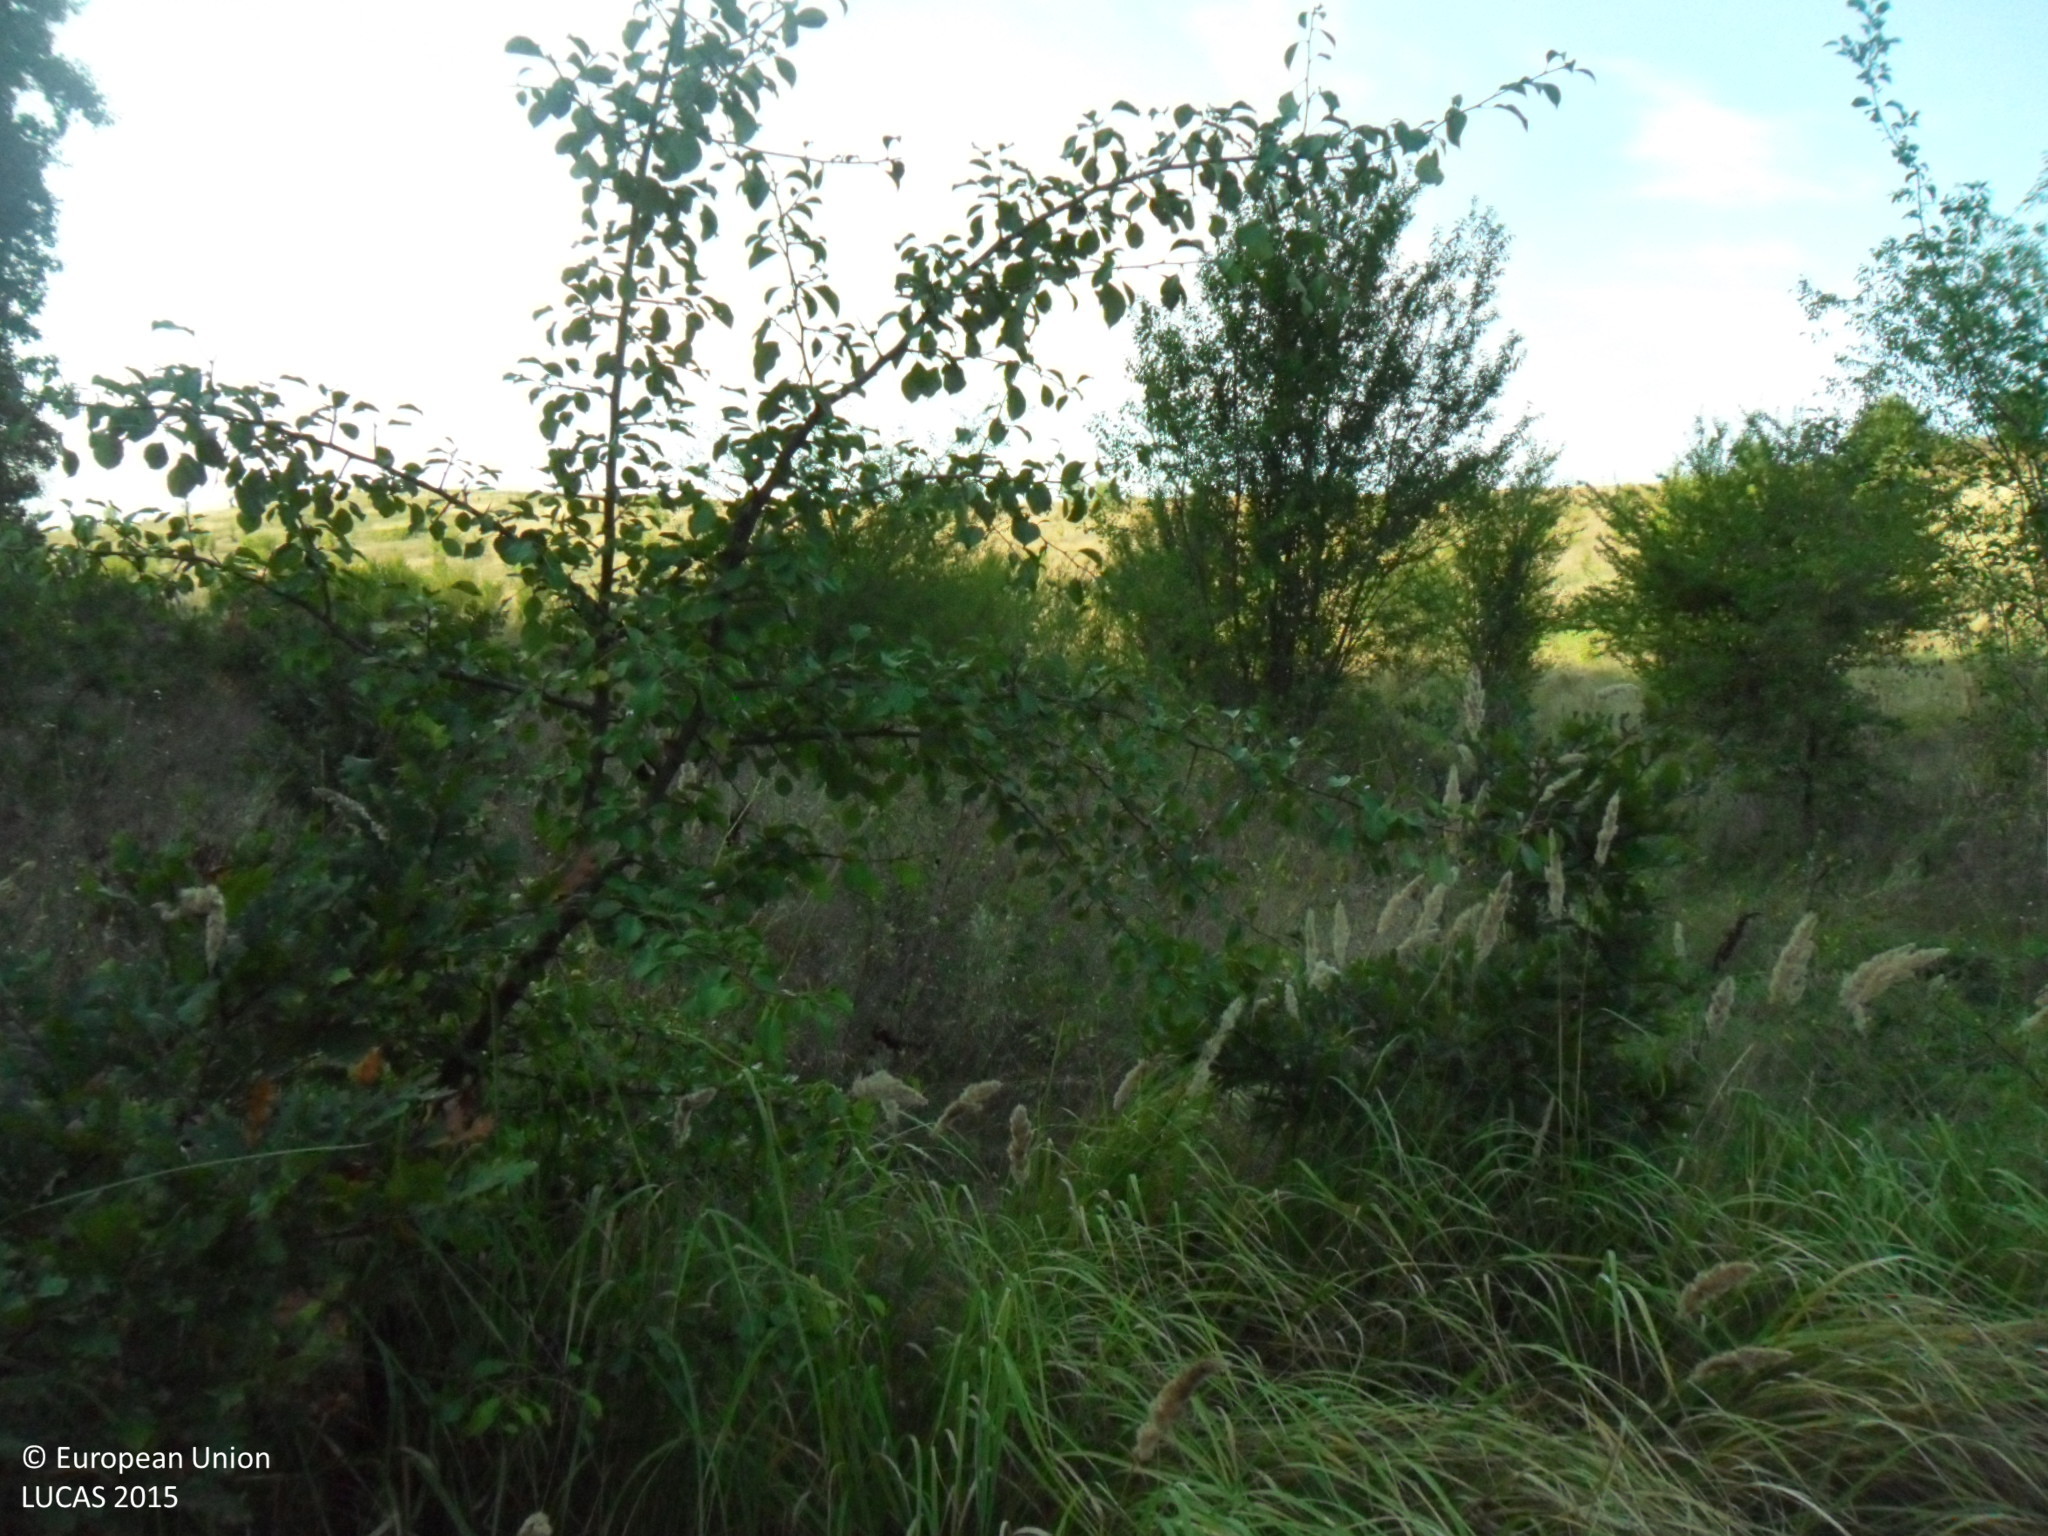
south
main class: Shrubland
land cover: Shrubland with sparse tree cover
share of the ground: > 75 %
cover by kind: shrubs 75 %, herbaceous plants 20 %, broadleaved forest trees 5 %
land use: Agriculture (excluding fallow land and kitchen gardens)
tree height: < 5 m
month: September
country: BG
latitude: 43.6211
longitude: 26.2978
